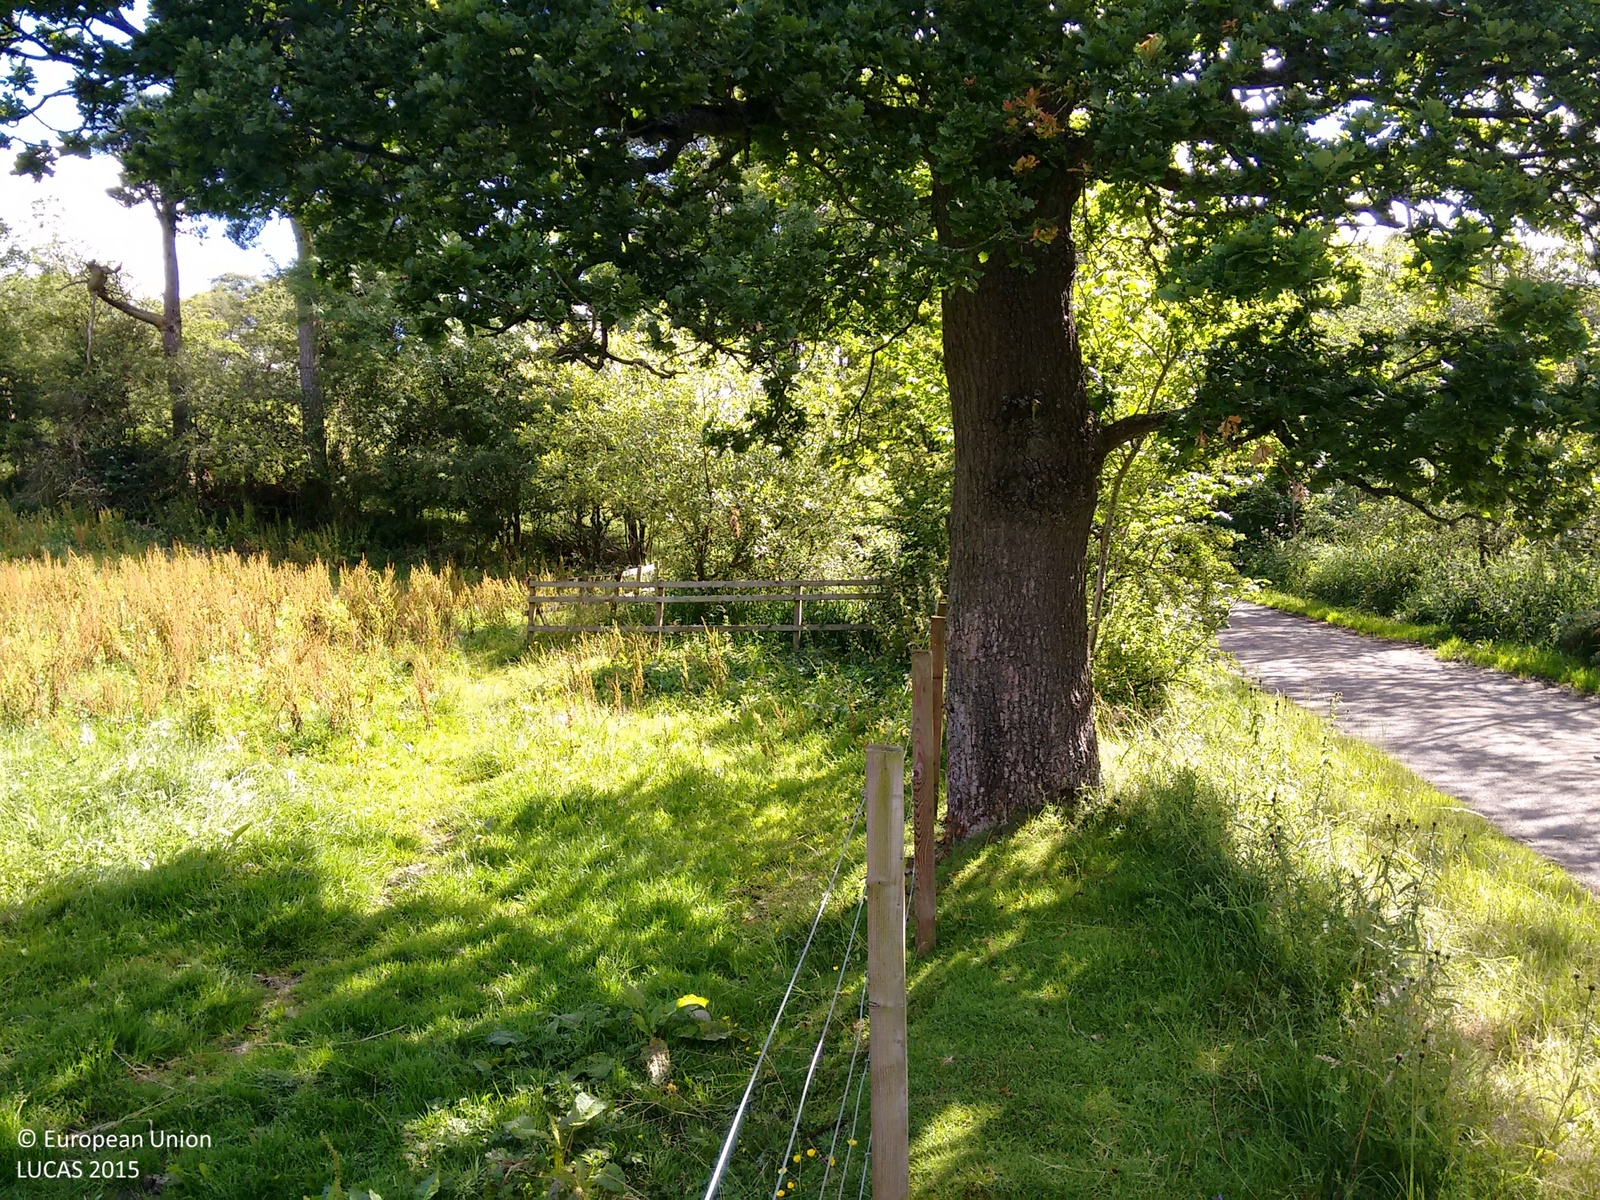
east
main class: Grassland
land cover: Grassland without tree/shrub cover
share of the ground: > 75 %
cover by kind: herbaceous plants 95 %, unconsolidated bare surface 5 %
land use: Agriculture (excluding fallow land and kitchen gardens)
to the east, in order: Grassland without tree/shrub cover; Fences; Pine dominated mixed woodland; Fences; Grassland without tree/shrub cover; Pine dominated mixed woodland; Grassland without tree/shrub cover; Fences; Pine dominated mixed woodland; Grassland without tree/shrub cover
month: August
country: GB
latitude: 55.9374
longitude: -3.7376
